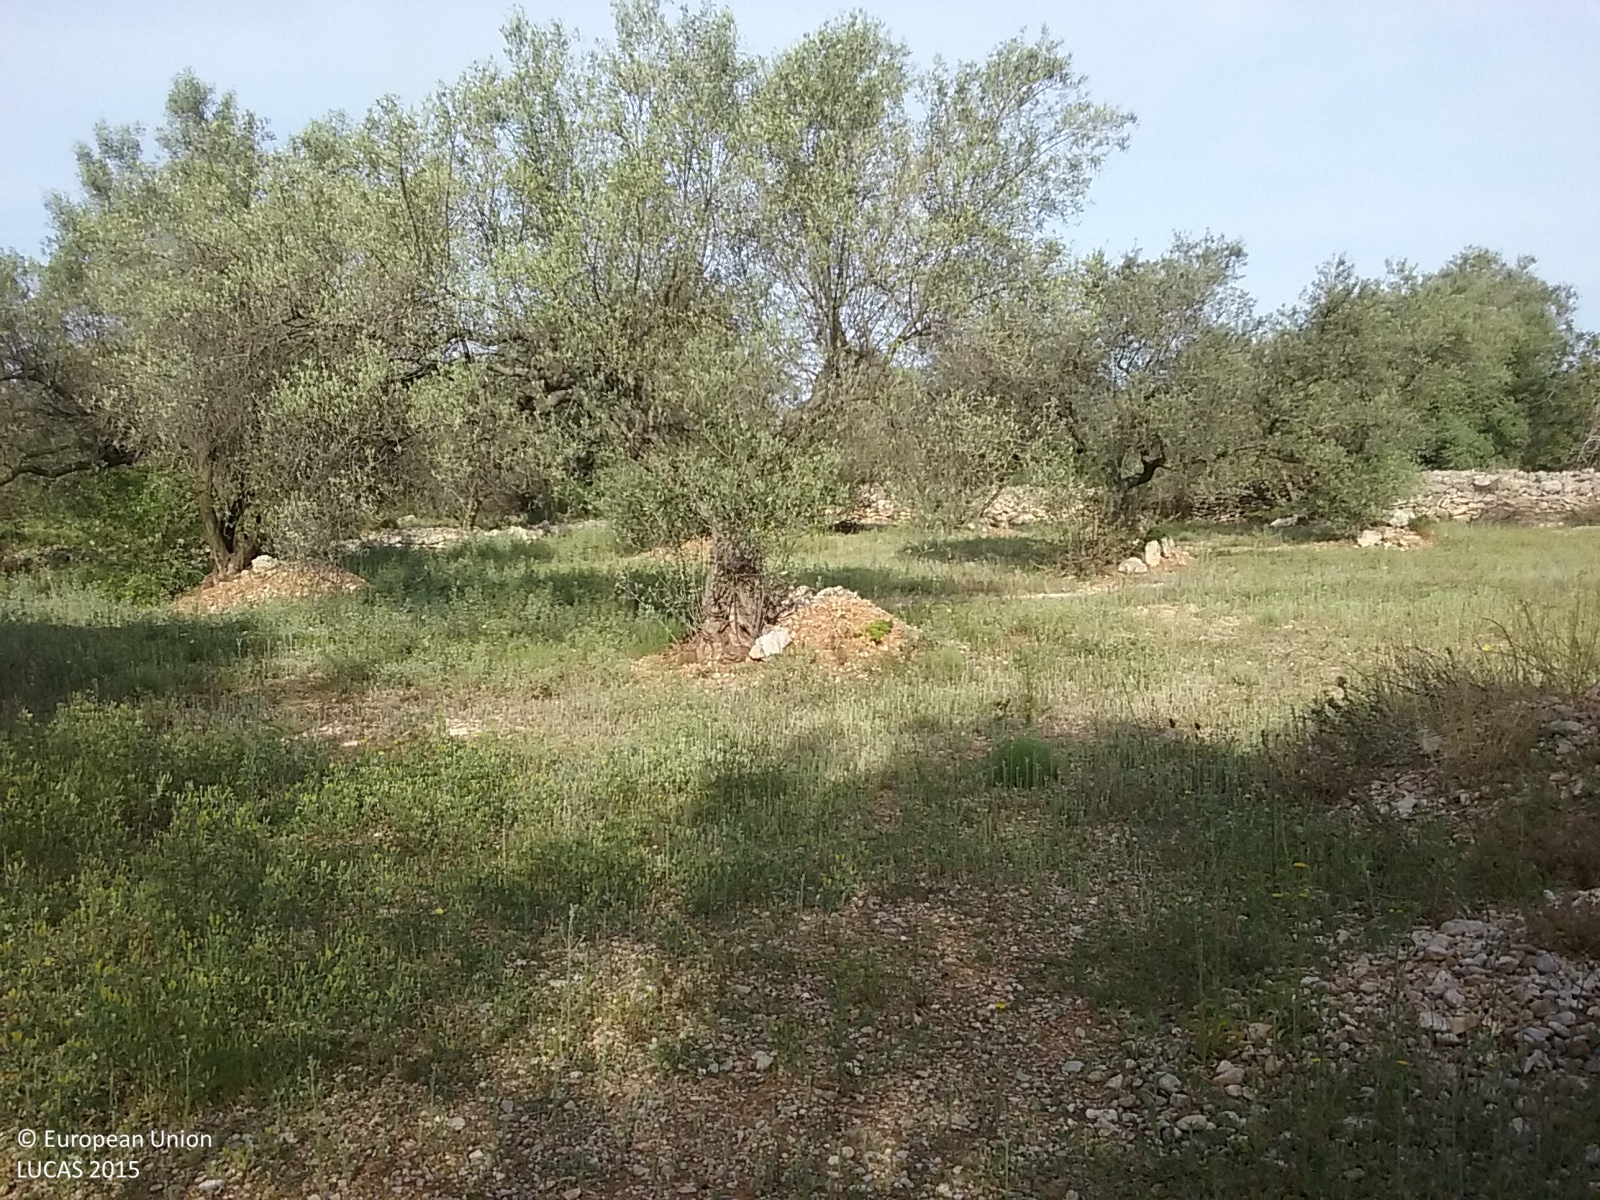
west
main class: Cropland
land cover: Olive groves
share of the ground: 25 - 50 %
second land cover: Grassland without tree/shrub cover
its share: > 75 %
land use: Agriculture (excluding fallow land and kitchen gardens)
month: May
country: ES
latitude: 40.6065
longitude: 0.3154
